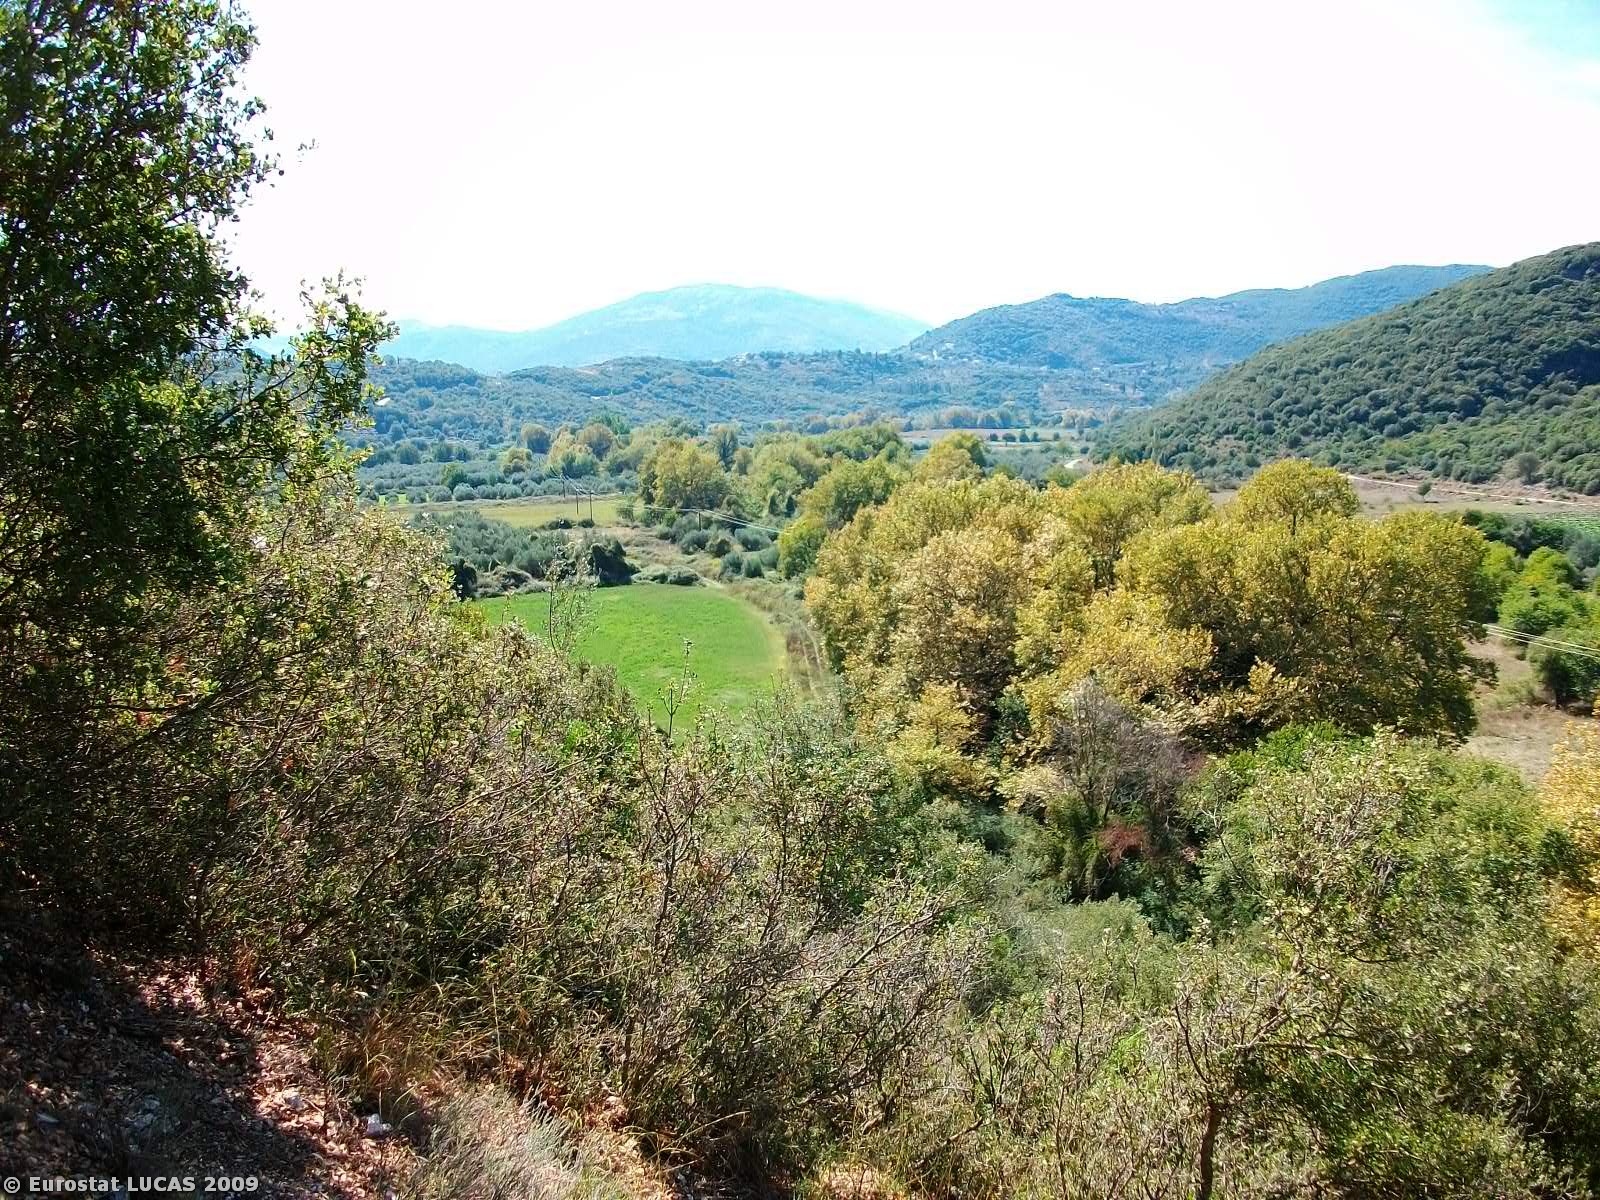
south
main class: Shrubland
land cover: Shrubland without tree cover
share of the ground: > 75 %
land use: Nature reserves
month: September
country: GR
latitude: 39.5933
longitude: 20.3270
